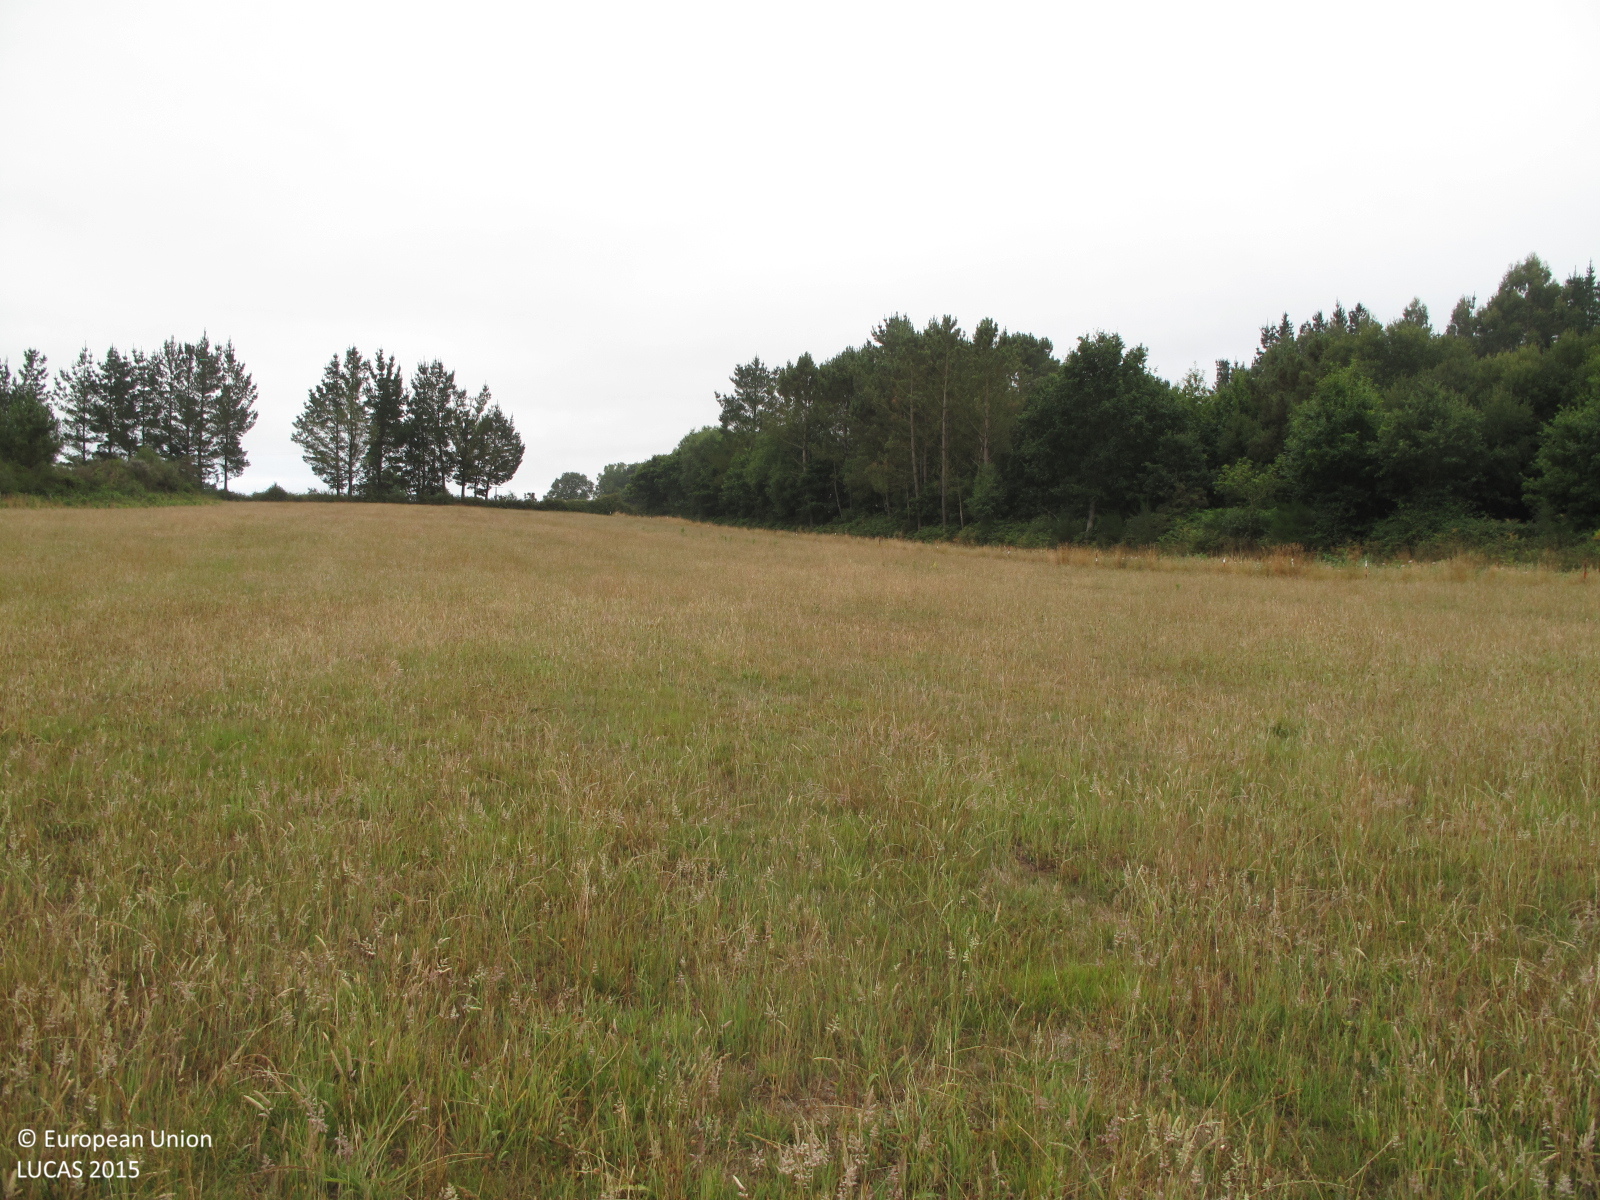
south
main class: Grassland
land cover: Grassland without tree/shrub cover
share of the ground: > 75 %
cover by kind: herbaceous plants 100 %
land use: Agriculture (excluding fallow land and kitchen gardens)
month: July
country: ES
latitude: 43.1769
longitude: -7.9406
